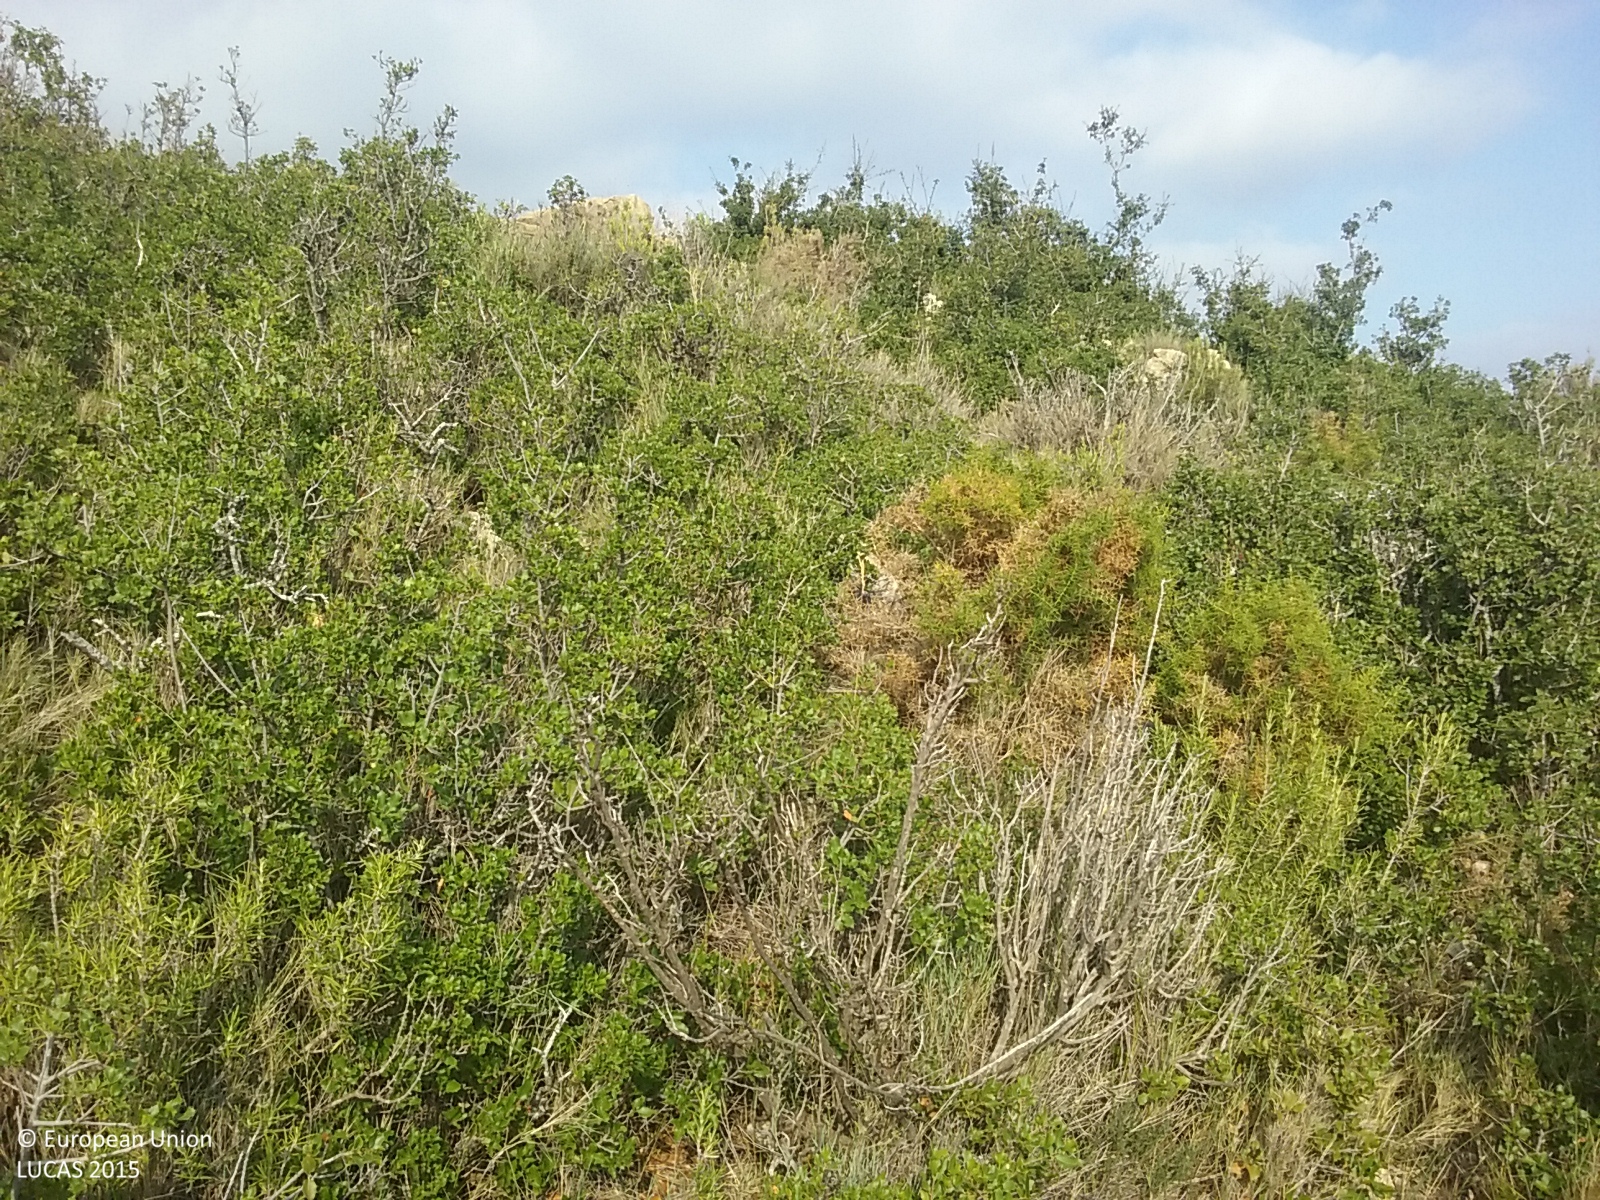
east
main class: Shrubland
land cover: Shrubland with sparse tree cover
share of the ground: > 75 %
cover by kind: shrubs 95 %, coniferous forest trees 5 %
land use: Semi-natural and natural areas not in use
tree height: < 5 m
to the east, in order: Shrubland with sparse tree cover; Dry stone walls; Shrubland with sparse tree cover; Dry stone walls; Olive groves; Dry stone walls; Olive groves; Electric lines; Olive groves; Dry stone walls; Shrubland with sparse tree cover; Dry stone walls; Shrubland with sparse tree cover; Dry stone walls; Nuts trees; Fences; Shrubland with sparse tree cover; Dry stone walls; Shrubland with sparse tree cover; Dry stone walls; Shrubland with sparse tree cover
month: August
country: ES
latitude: 40.3466
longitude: -0.0942
